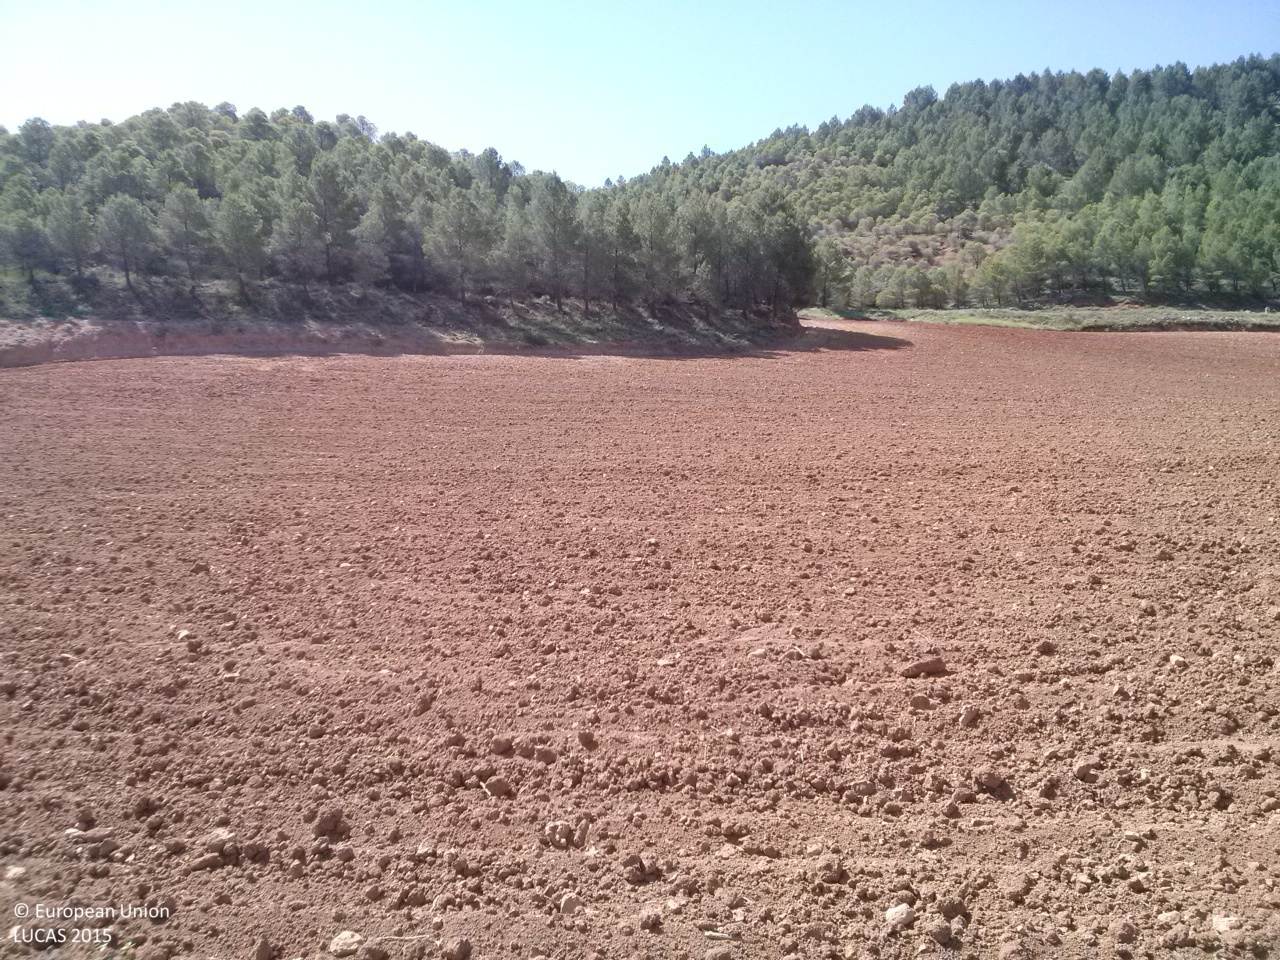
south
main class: Cropland
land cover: Sunflower
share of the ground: < 10 %
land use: Agriculture (excluding fallow land and kitchen gardens)
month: May
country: ES
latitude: 40.1681
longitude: -2.5735
